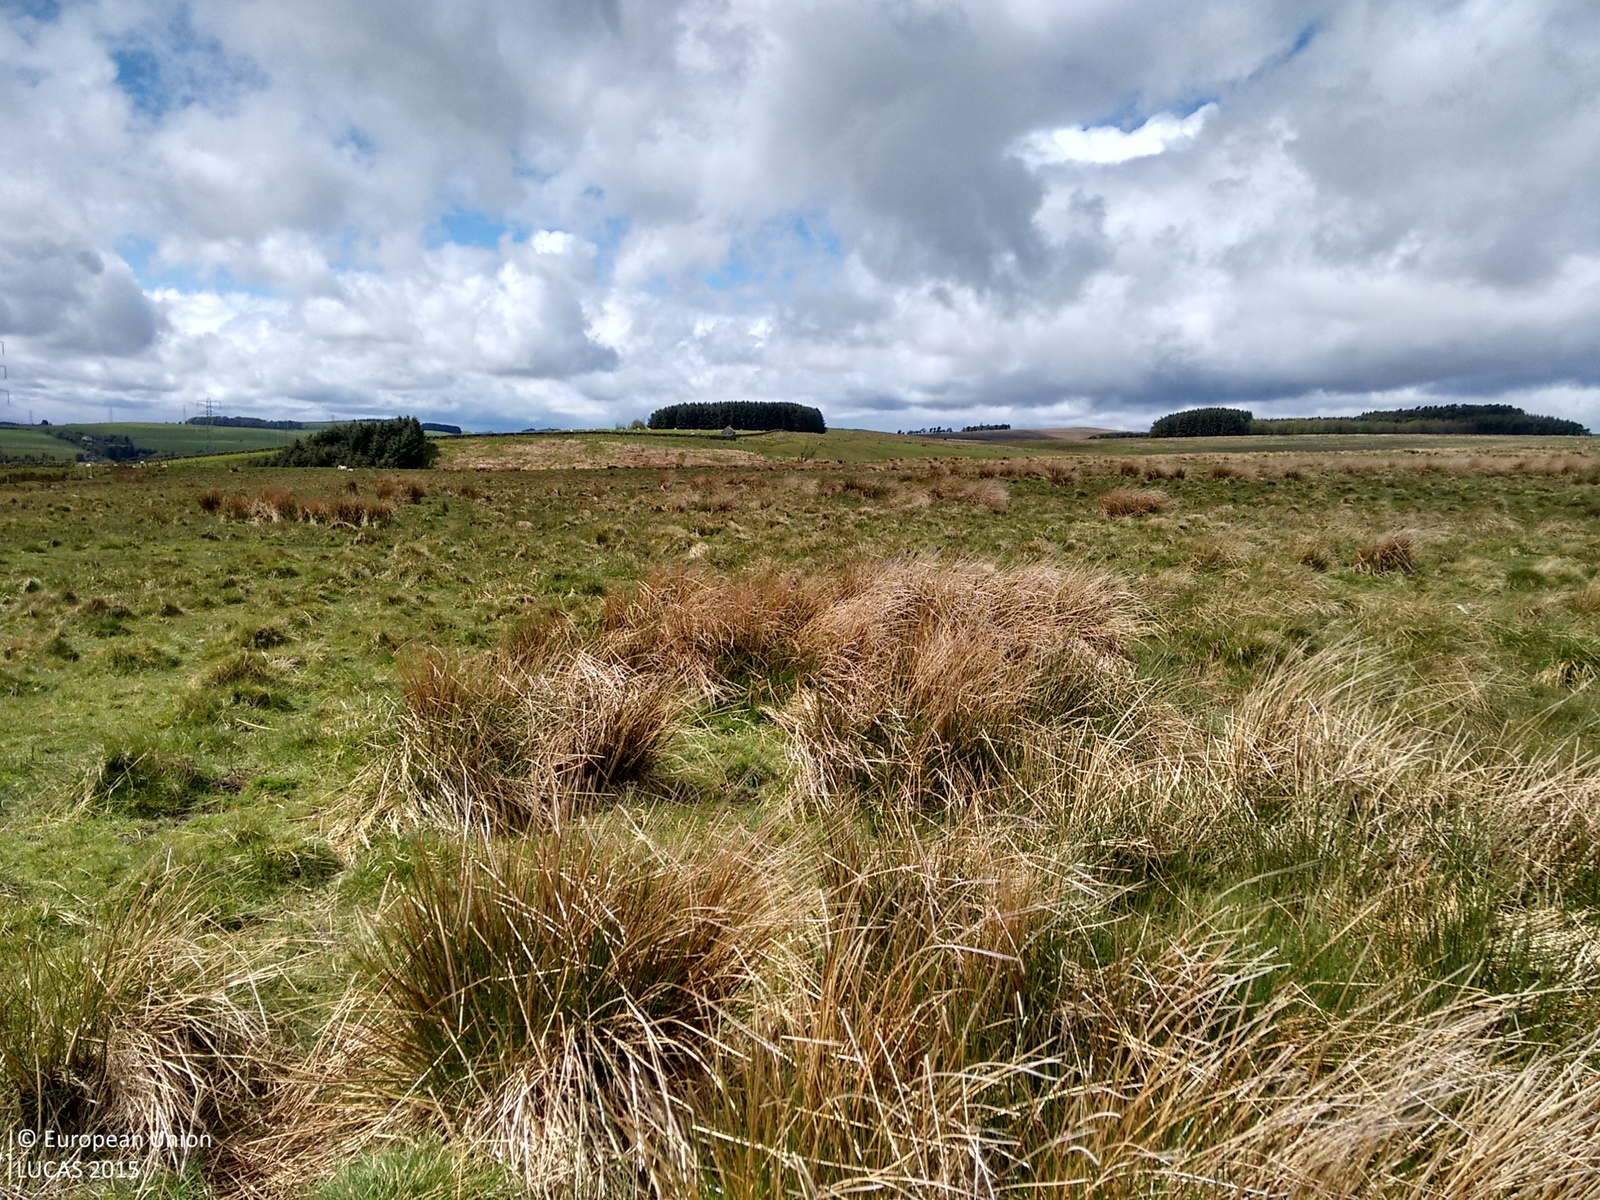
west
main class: Grassland
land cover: Grassland without tree/shrub cover
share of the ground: > 75 %
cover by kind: herbaceous plants 100 %
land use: Agriculture (excluding fallow land and kitchen gardens)
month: May
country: GB
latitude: 55.0194
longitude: -2.2105
